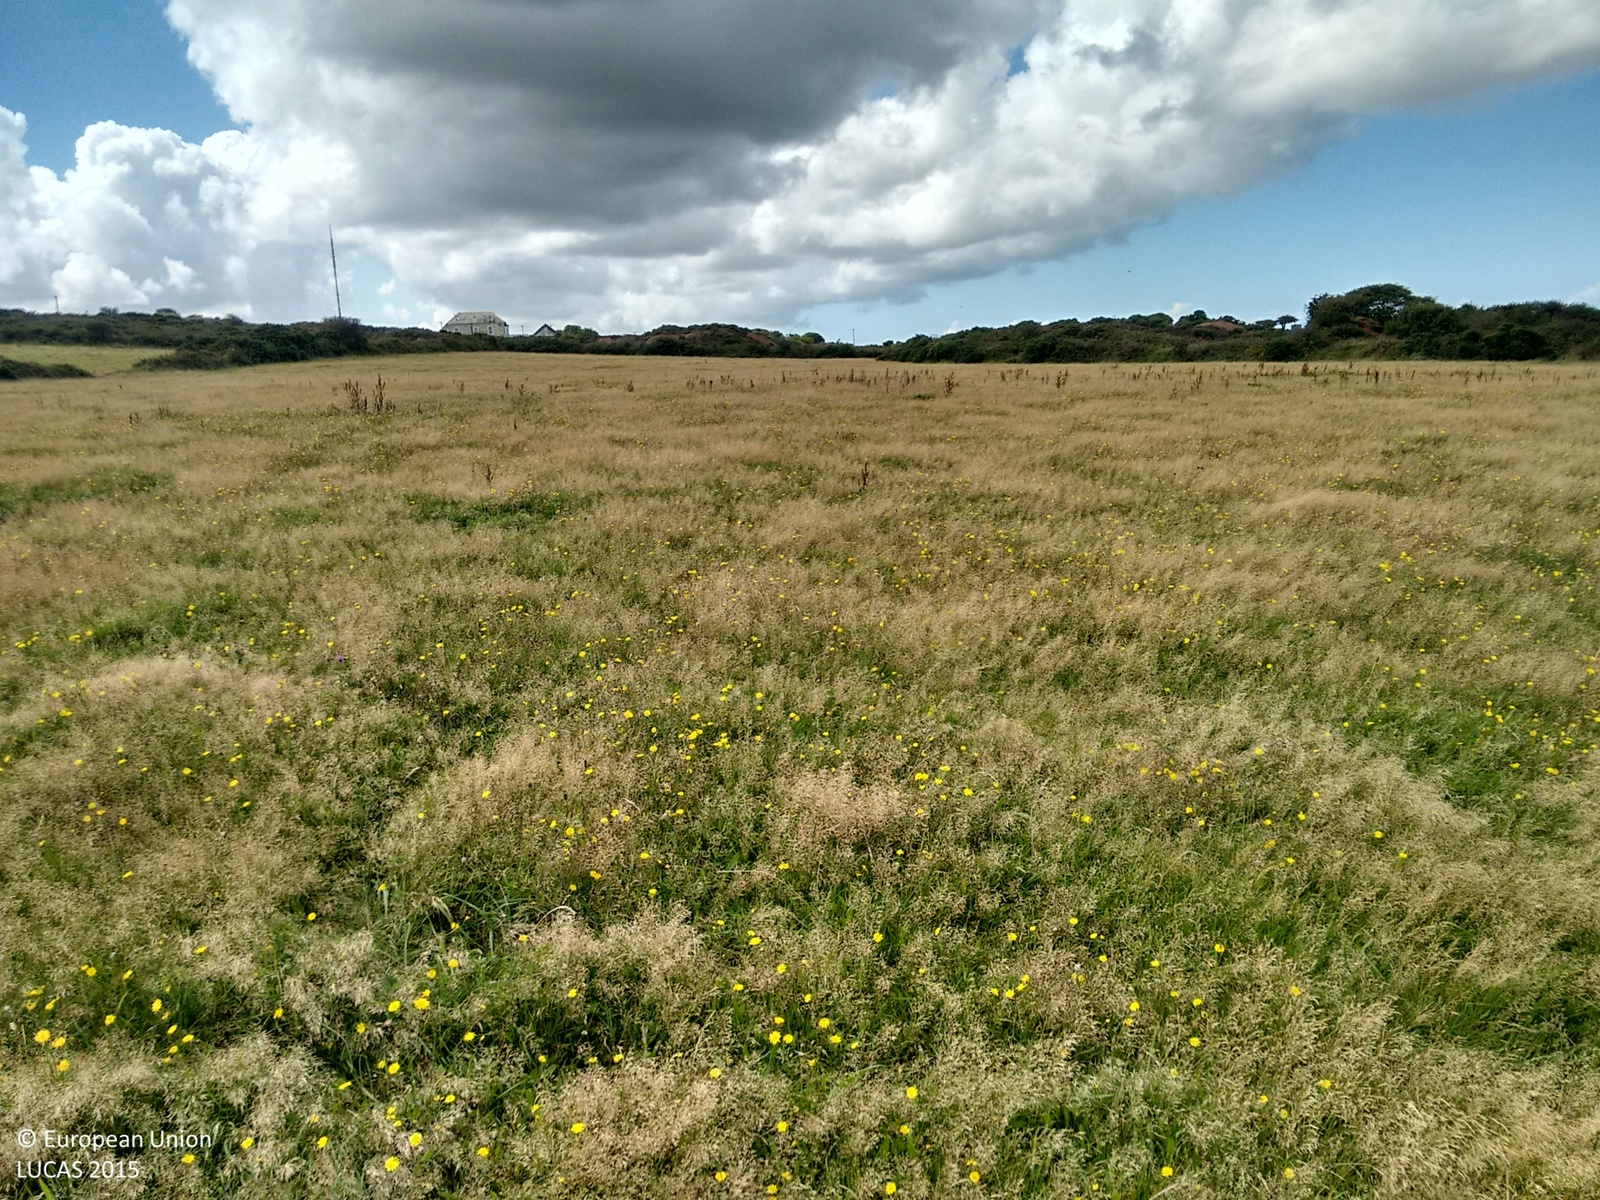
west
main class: Grassland
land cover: Grassland without tree/shrub cover
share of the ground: > 75 %
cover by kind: herbaceous plants 100 %
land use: Agriculture (excluding fallow land and kitchen gardens)
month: August
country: GB
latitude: 50.2169
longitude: -5.2142
